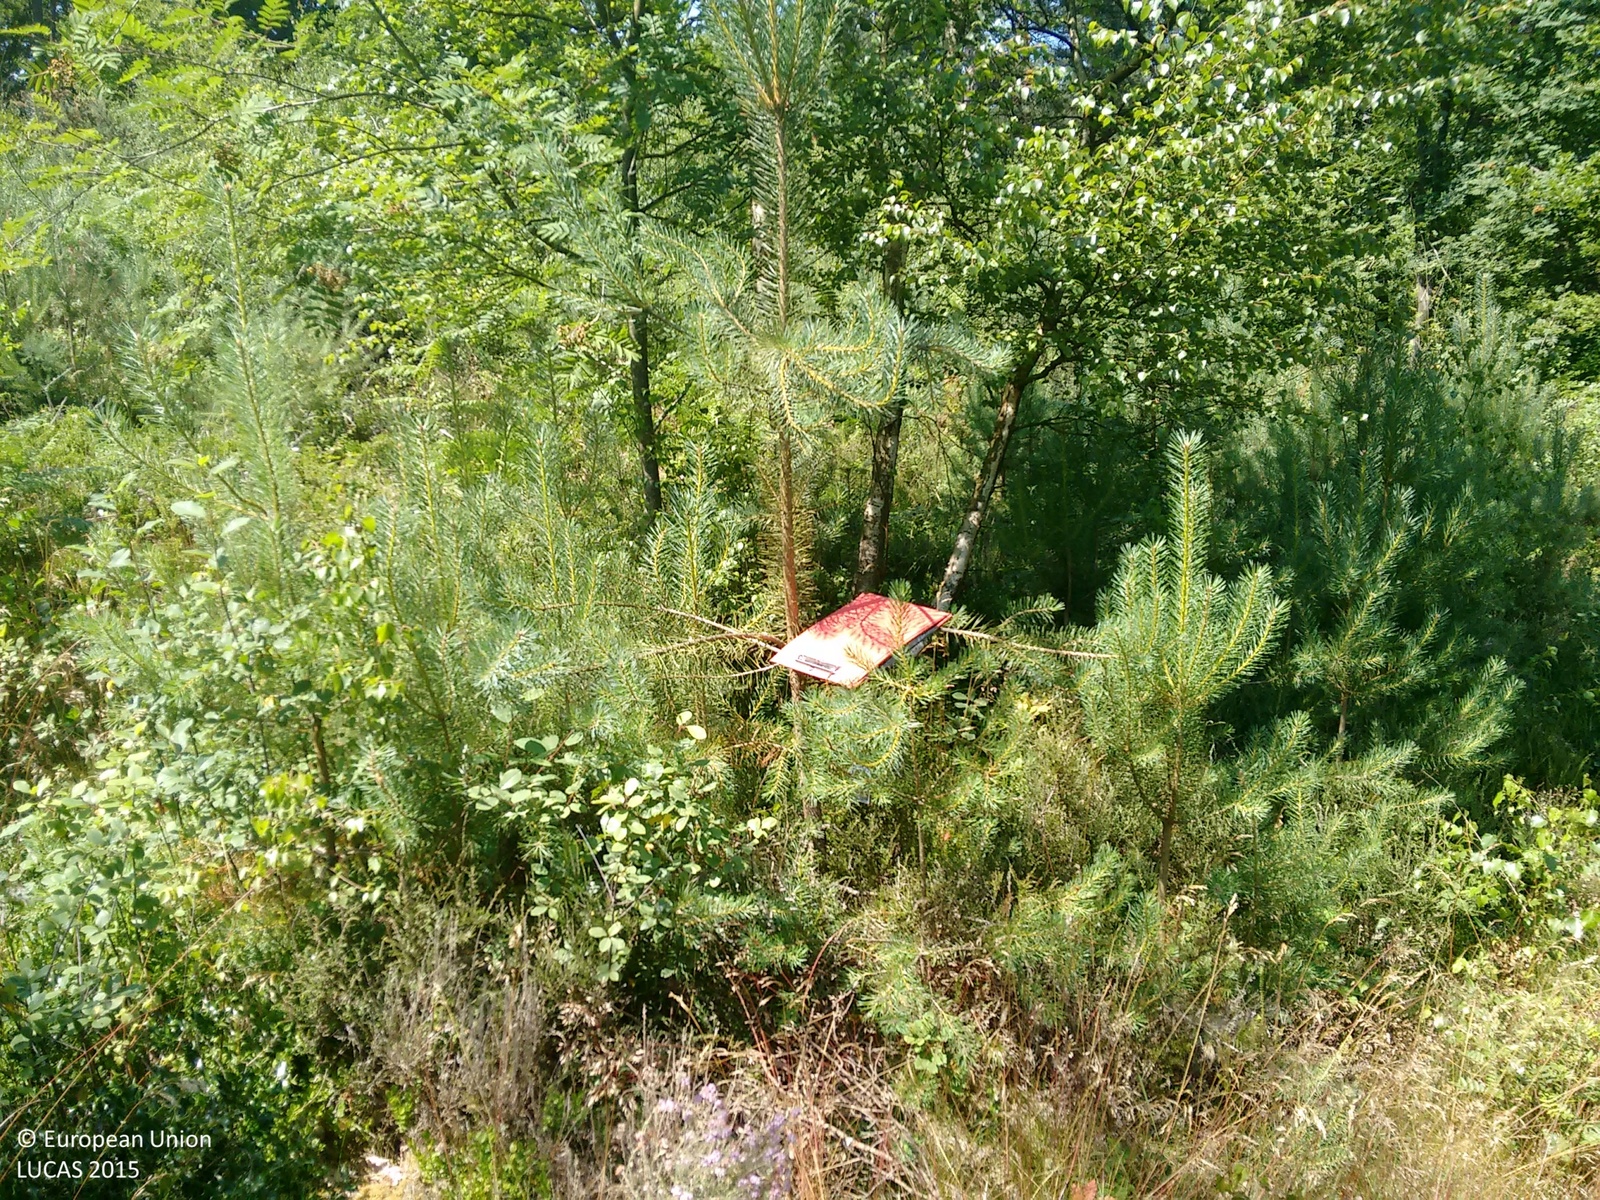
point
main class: Shrubland
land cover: Shrubland with sparse tree cover
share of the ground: > 75 %
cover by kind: shrubs 95 %, broadleaved forest trees 5 %
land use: Forestry
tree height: > 5 m
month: July
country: GB
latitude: 51.1905
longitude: -0.4400
